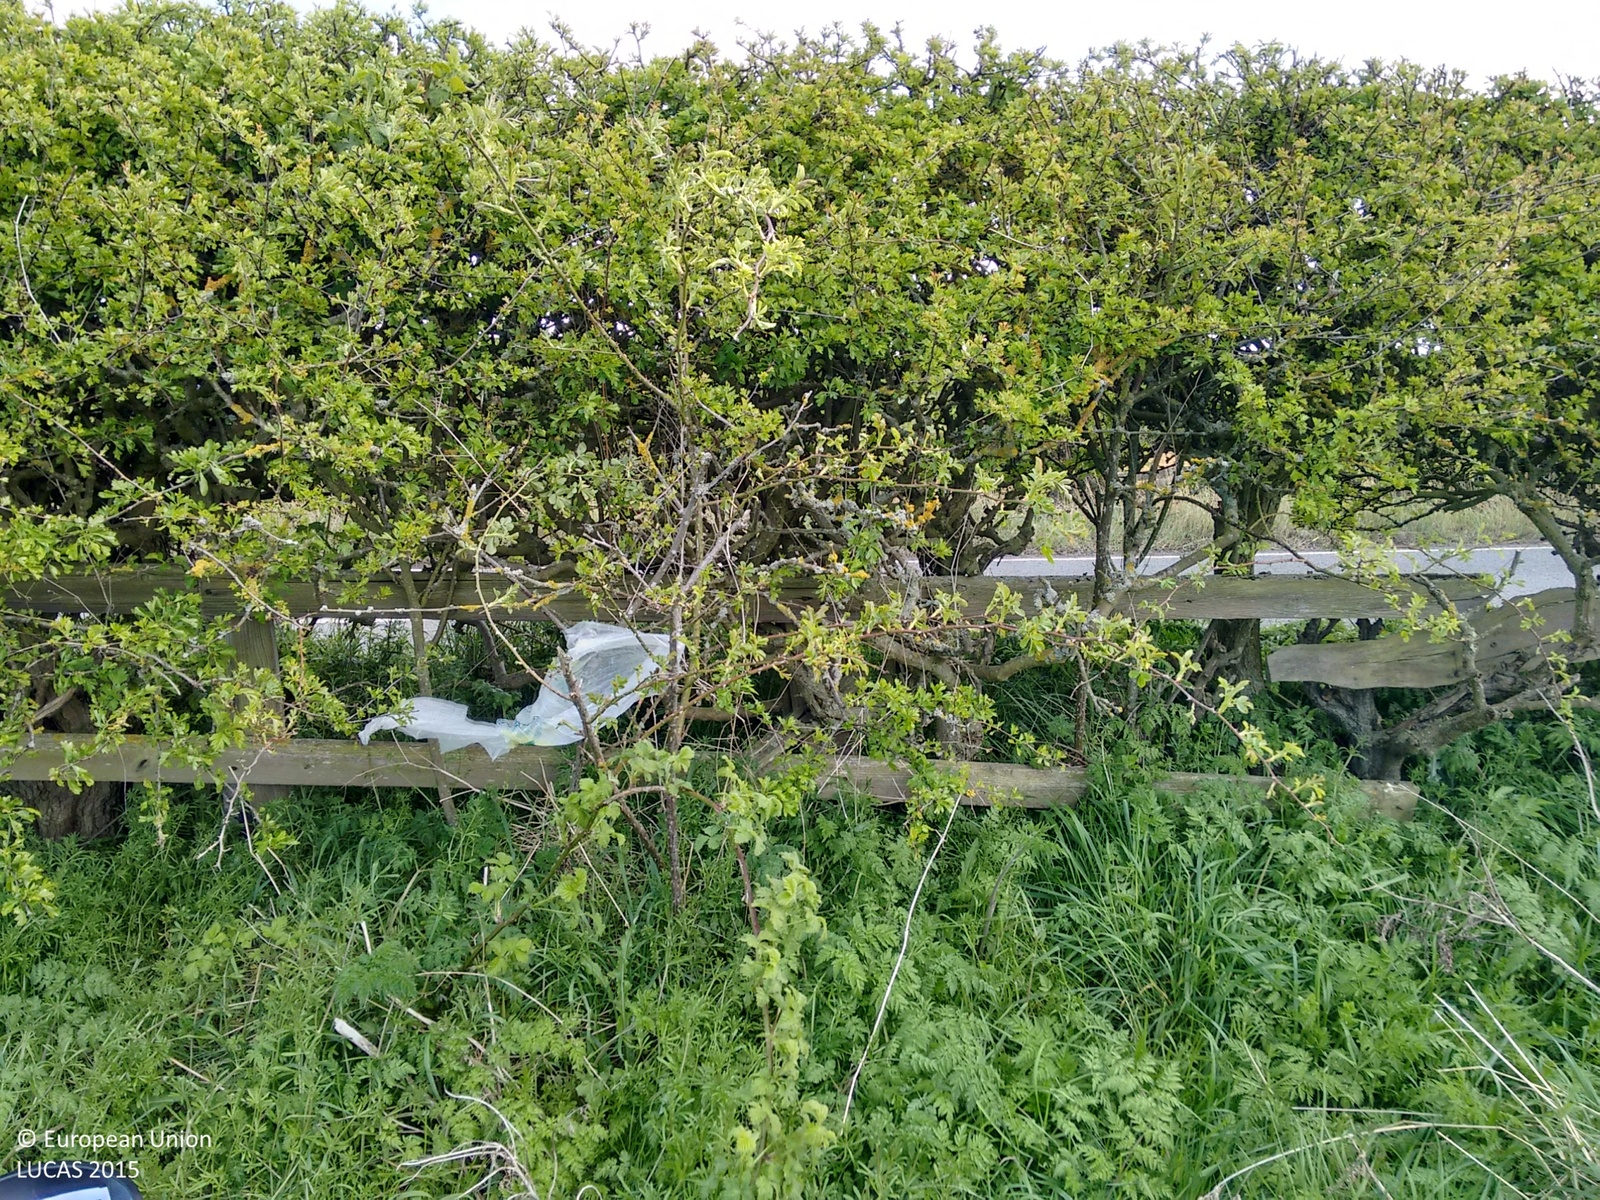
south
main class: Cropland
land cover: Oats
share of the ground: > 75 %
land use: Agriculture (excluding fallow land and kitchen gardens)
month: May
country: GB
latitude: 55.0488
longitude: -1.5203
